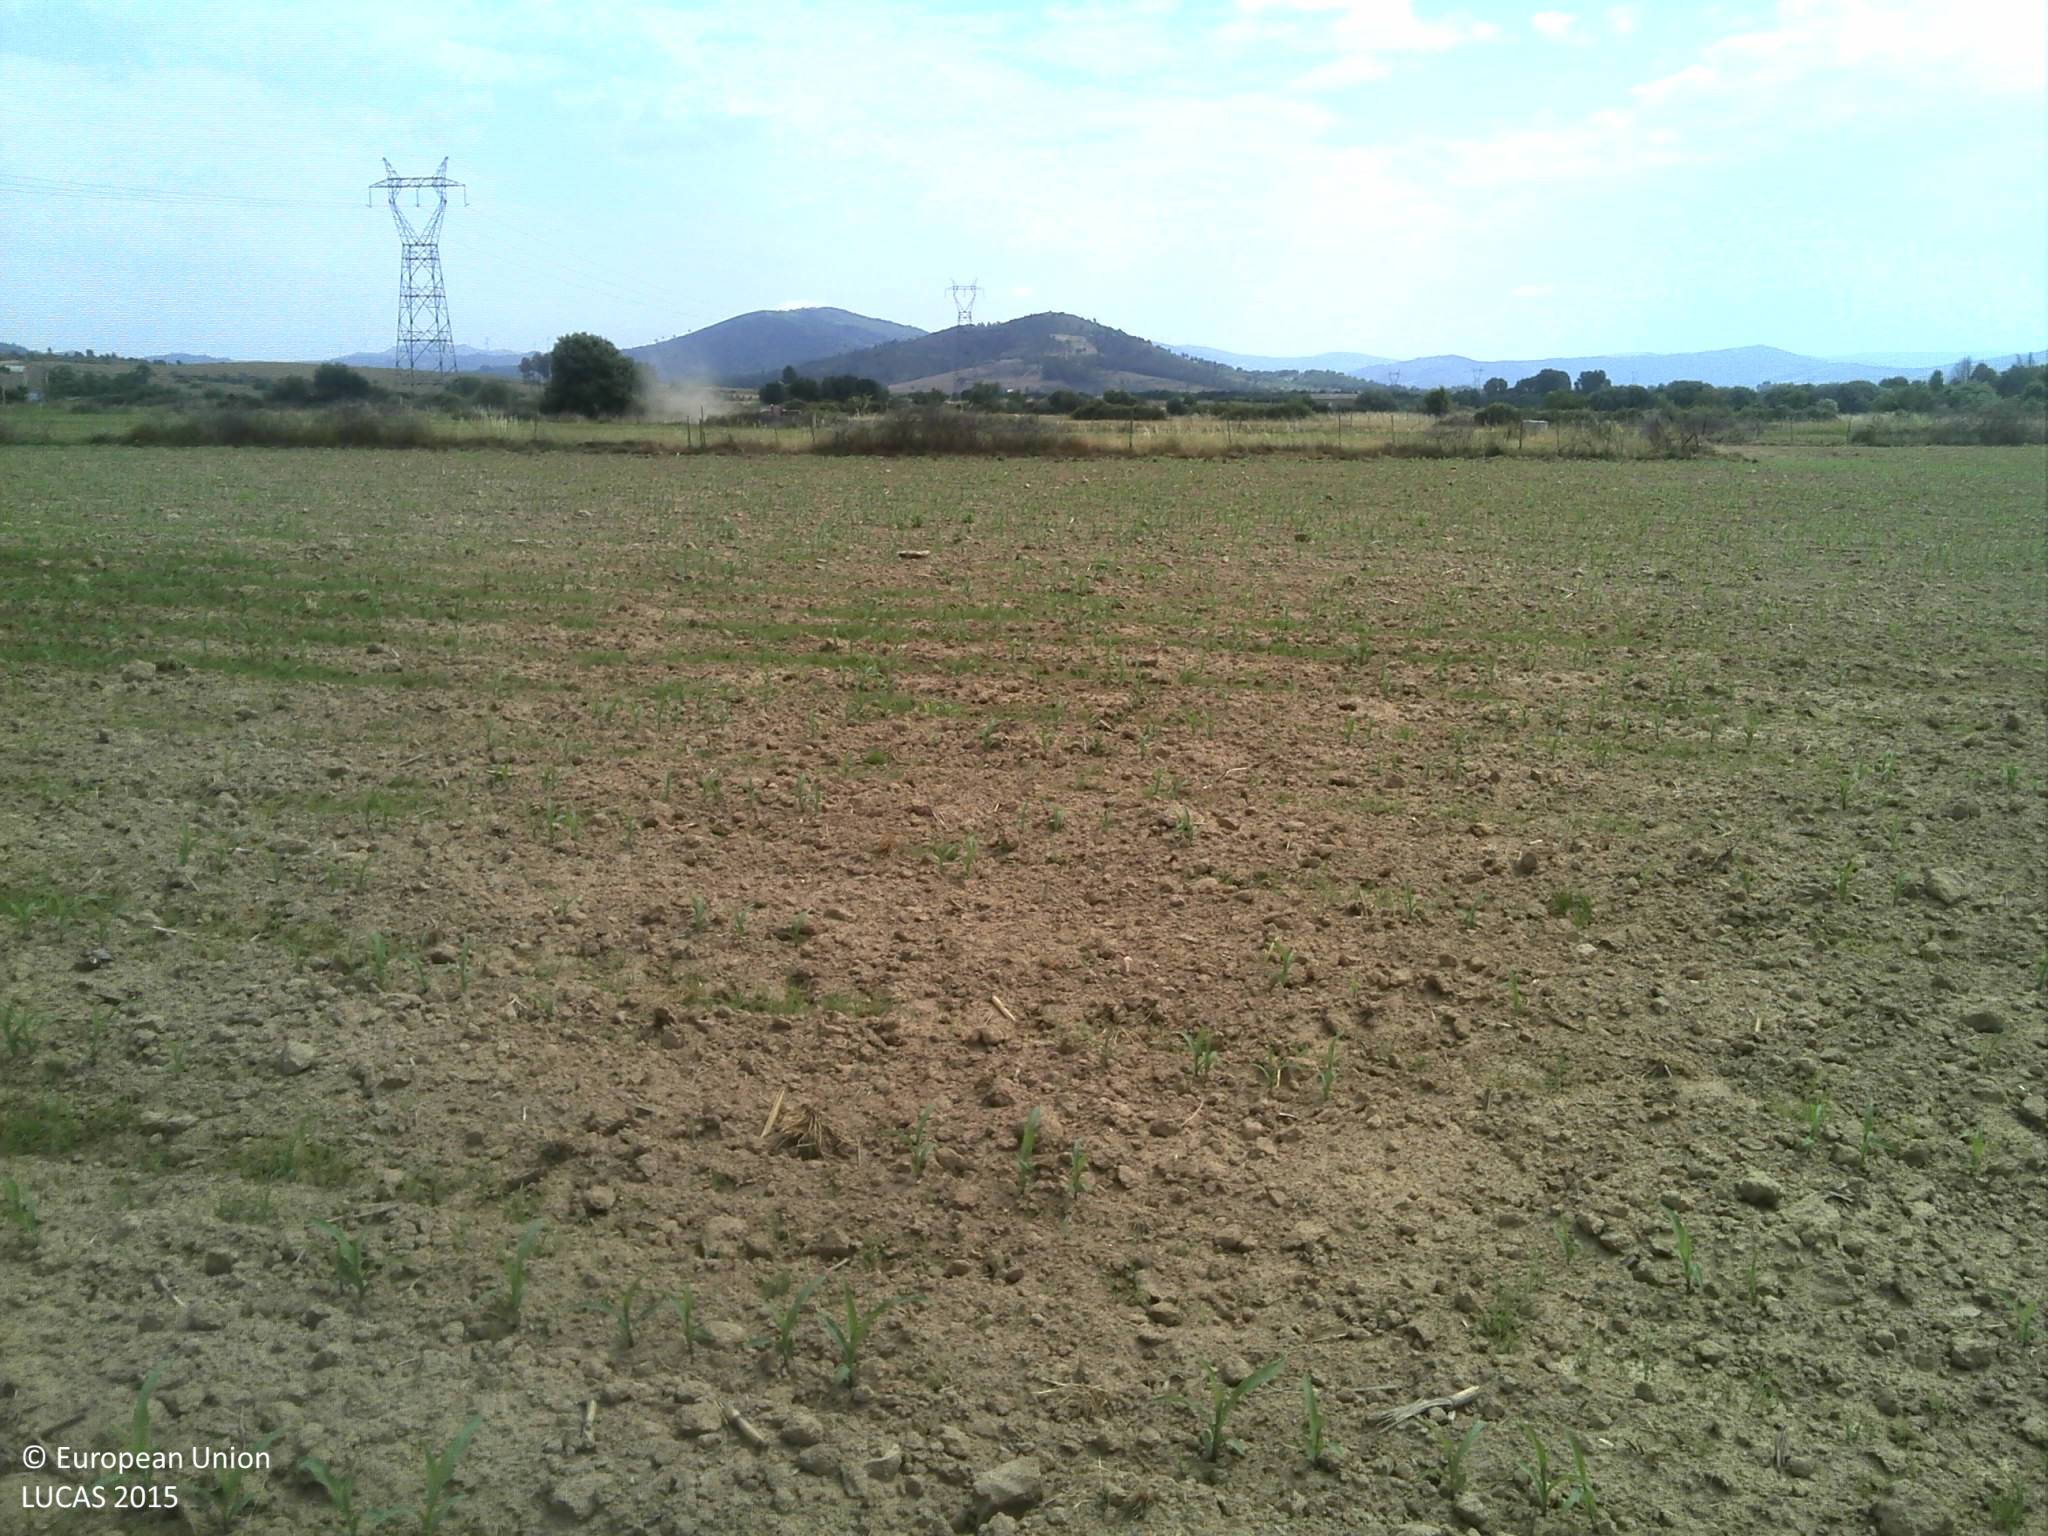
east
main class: Cropland
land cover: Maize
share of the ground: < 10 %
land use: Agriculture (excluding fallow land and kitchen gardens)
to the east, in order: Maize; Fences; Grassland without tree/shrub cover; Fences; Grassland without tree/shrub cover; Fences; Rye
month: June
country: PT
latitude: 40.2350
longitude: -7.2730
